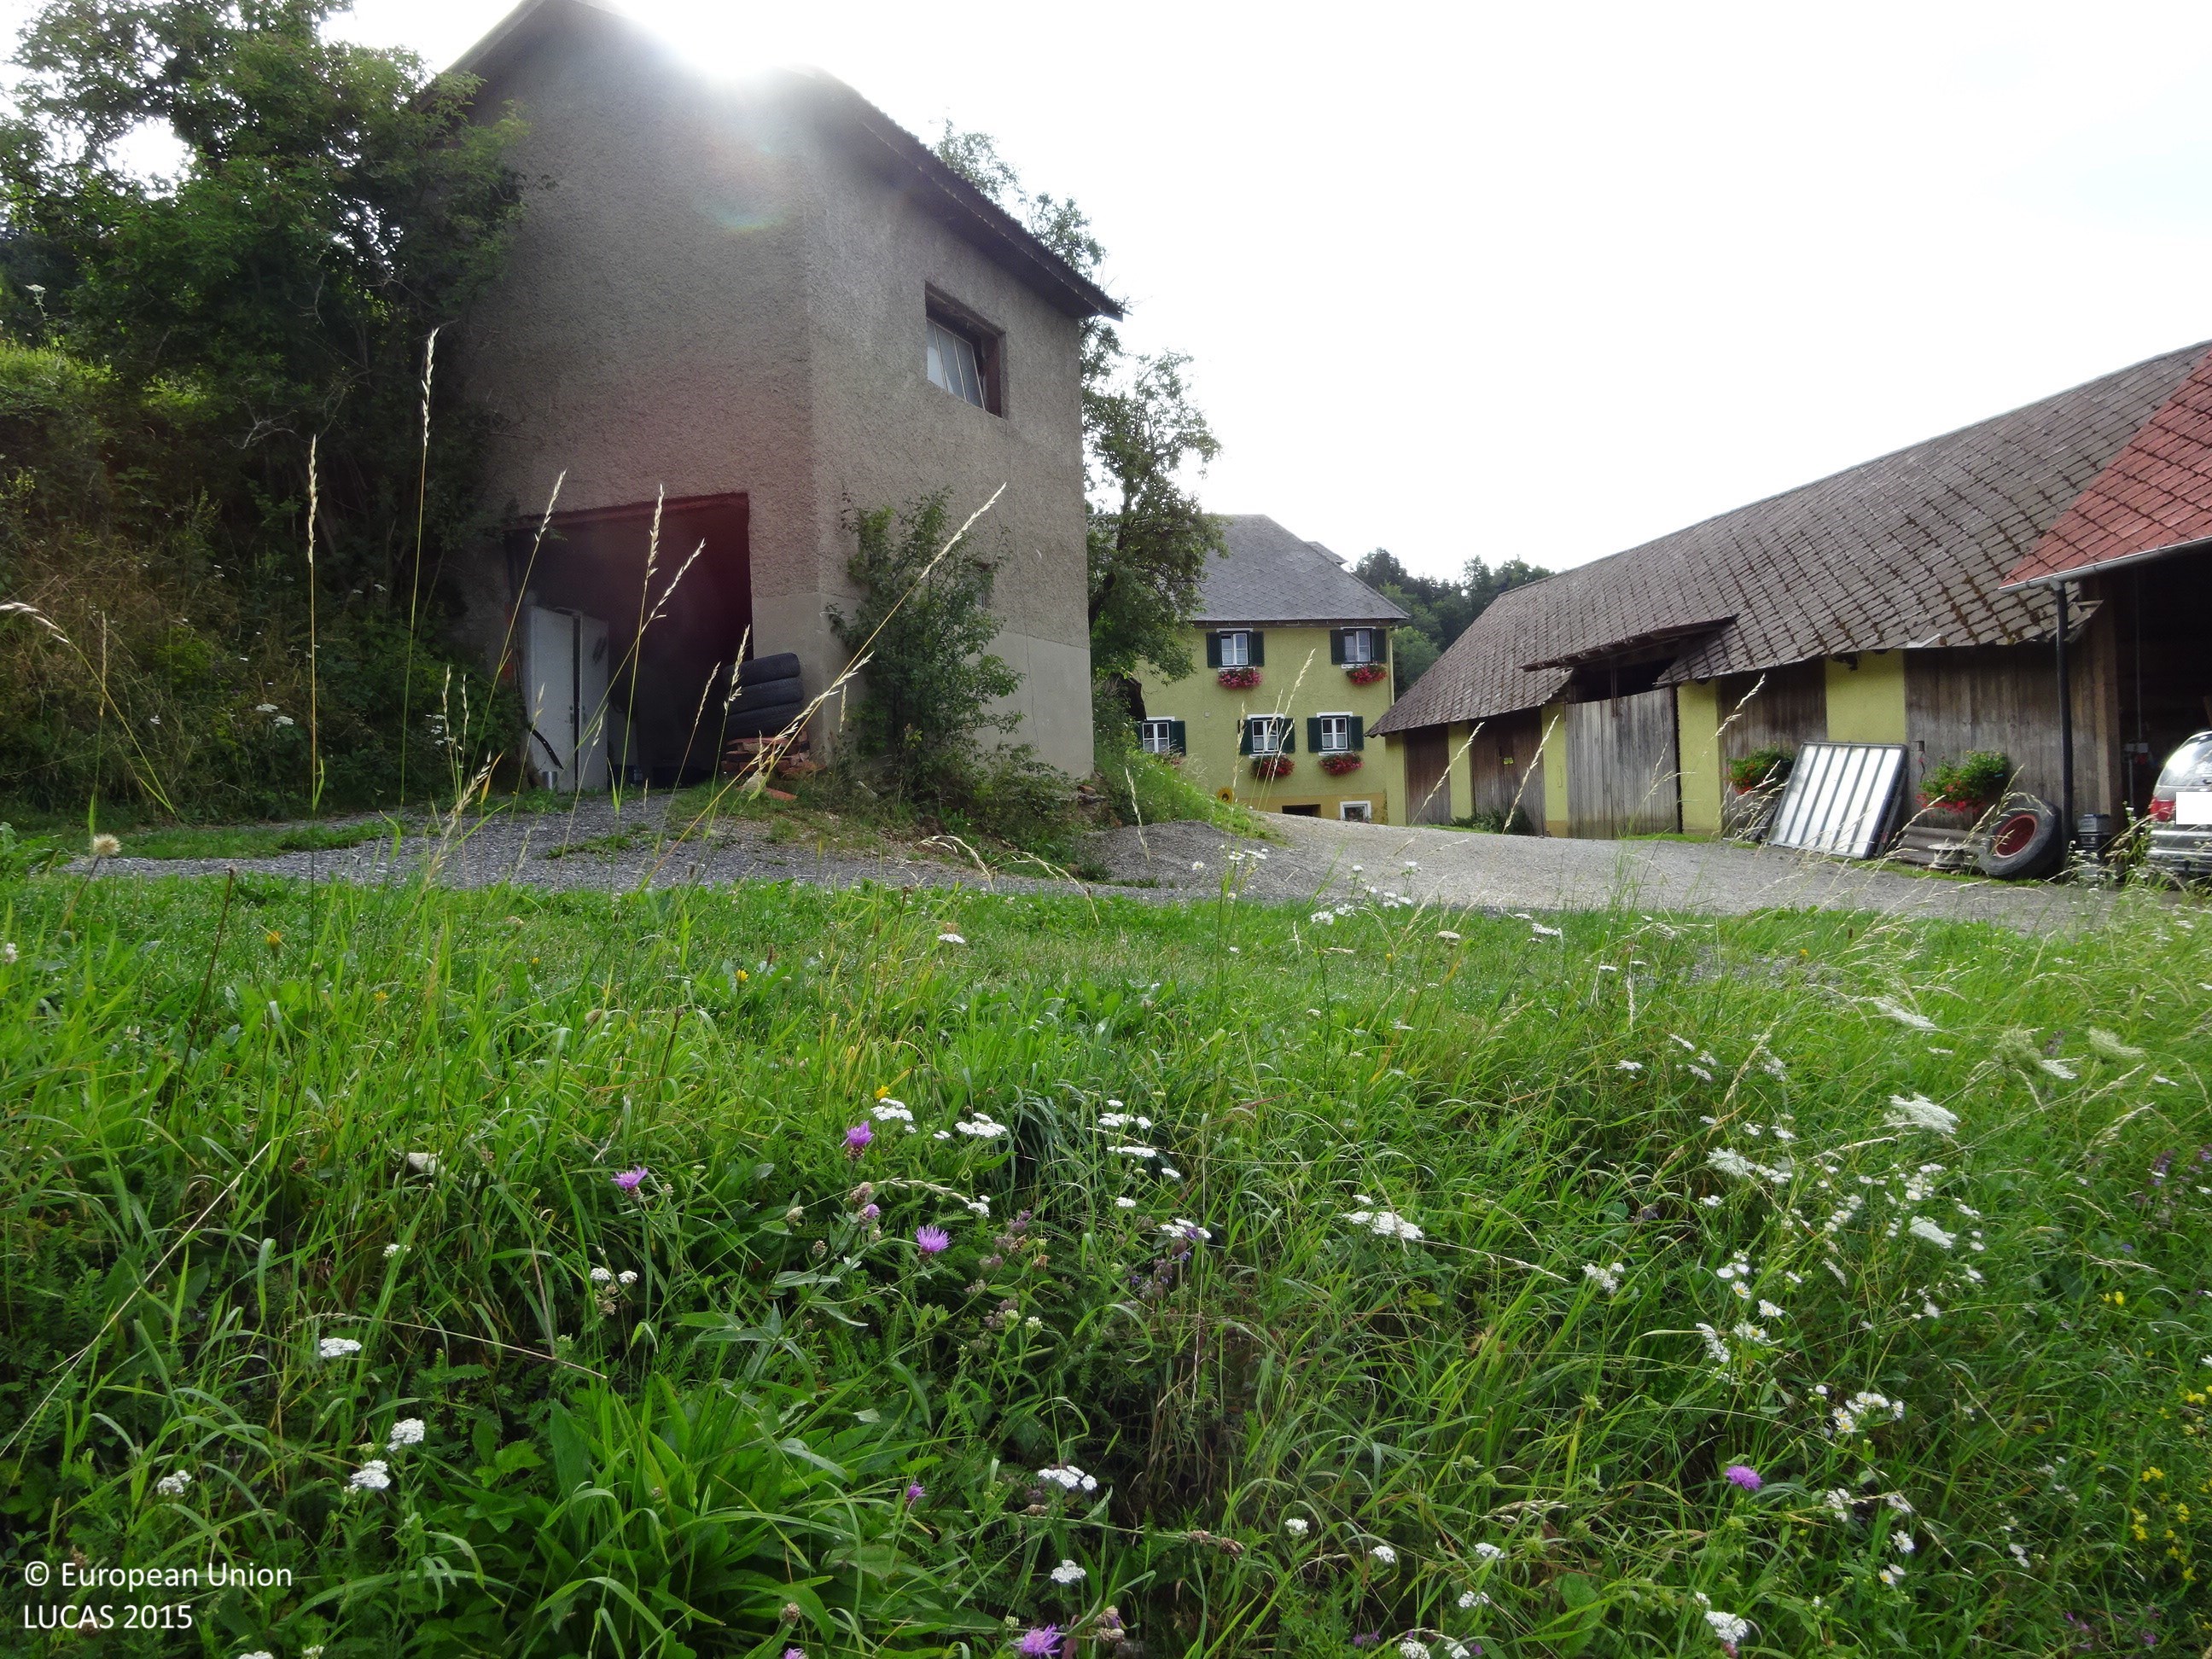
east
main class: Cropland
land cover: Cherry fruit
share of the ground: 10 - 25 %
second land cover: Grassland without tree/shrub cover
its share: > 75 %
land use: Agriculture (excluding fallow land and kitchen gardens)
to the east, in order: Cherry fruit; Grassland without tree/shrub cover; Artificial constructions in urban areas; Clovers; Grassland without tree/shrub cover; Paved roads, cycling and walking lanes; Broadleaved woodland; Paved roads, cycling and walking lanes; Spruce dominated mixed woodland; Spruce dominated coniferous woodland
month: July
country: AT
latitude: 47.2459
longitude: 15.3508
